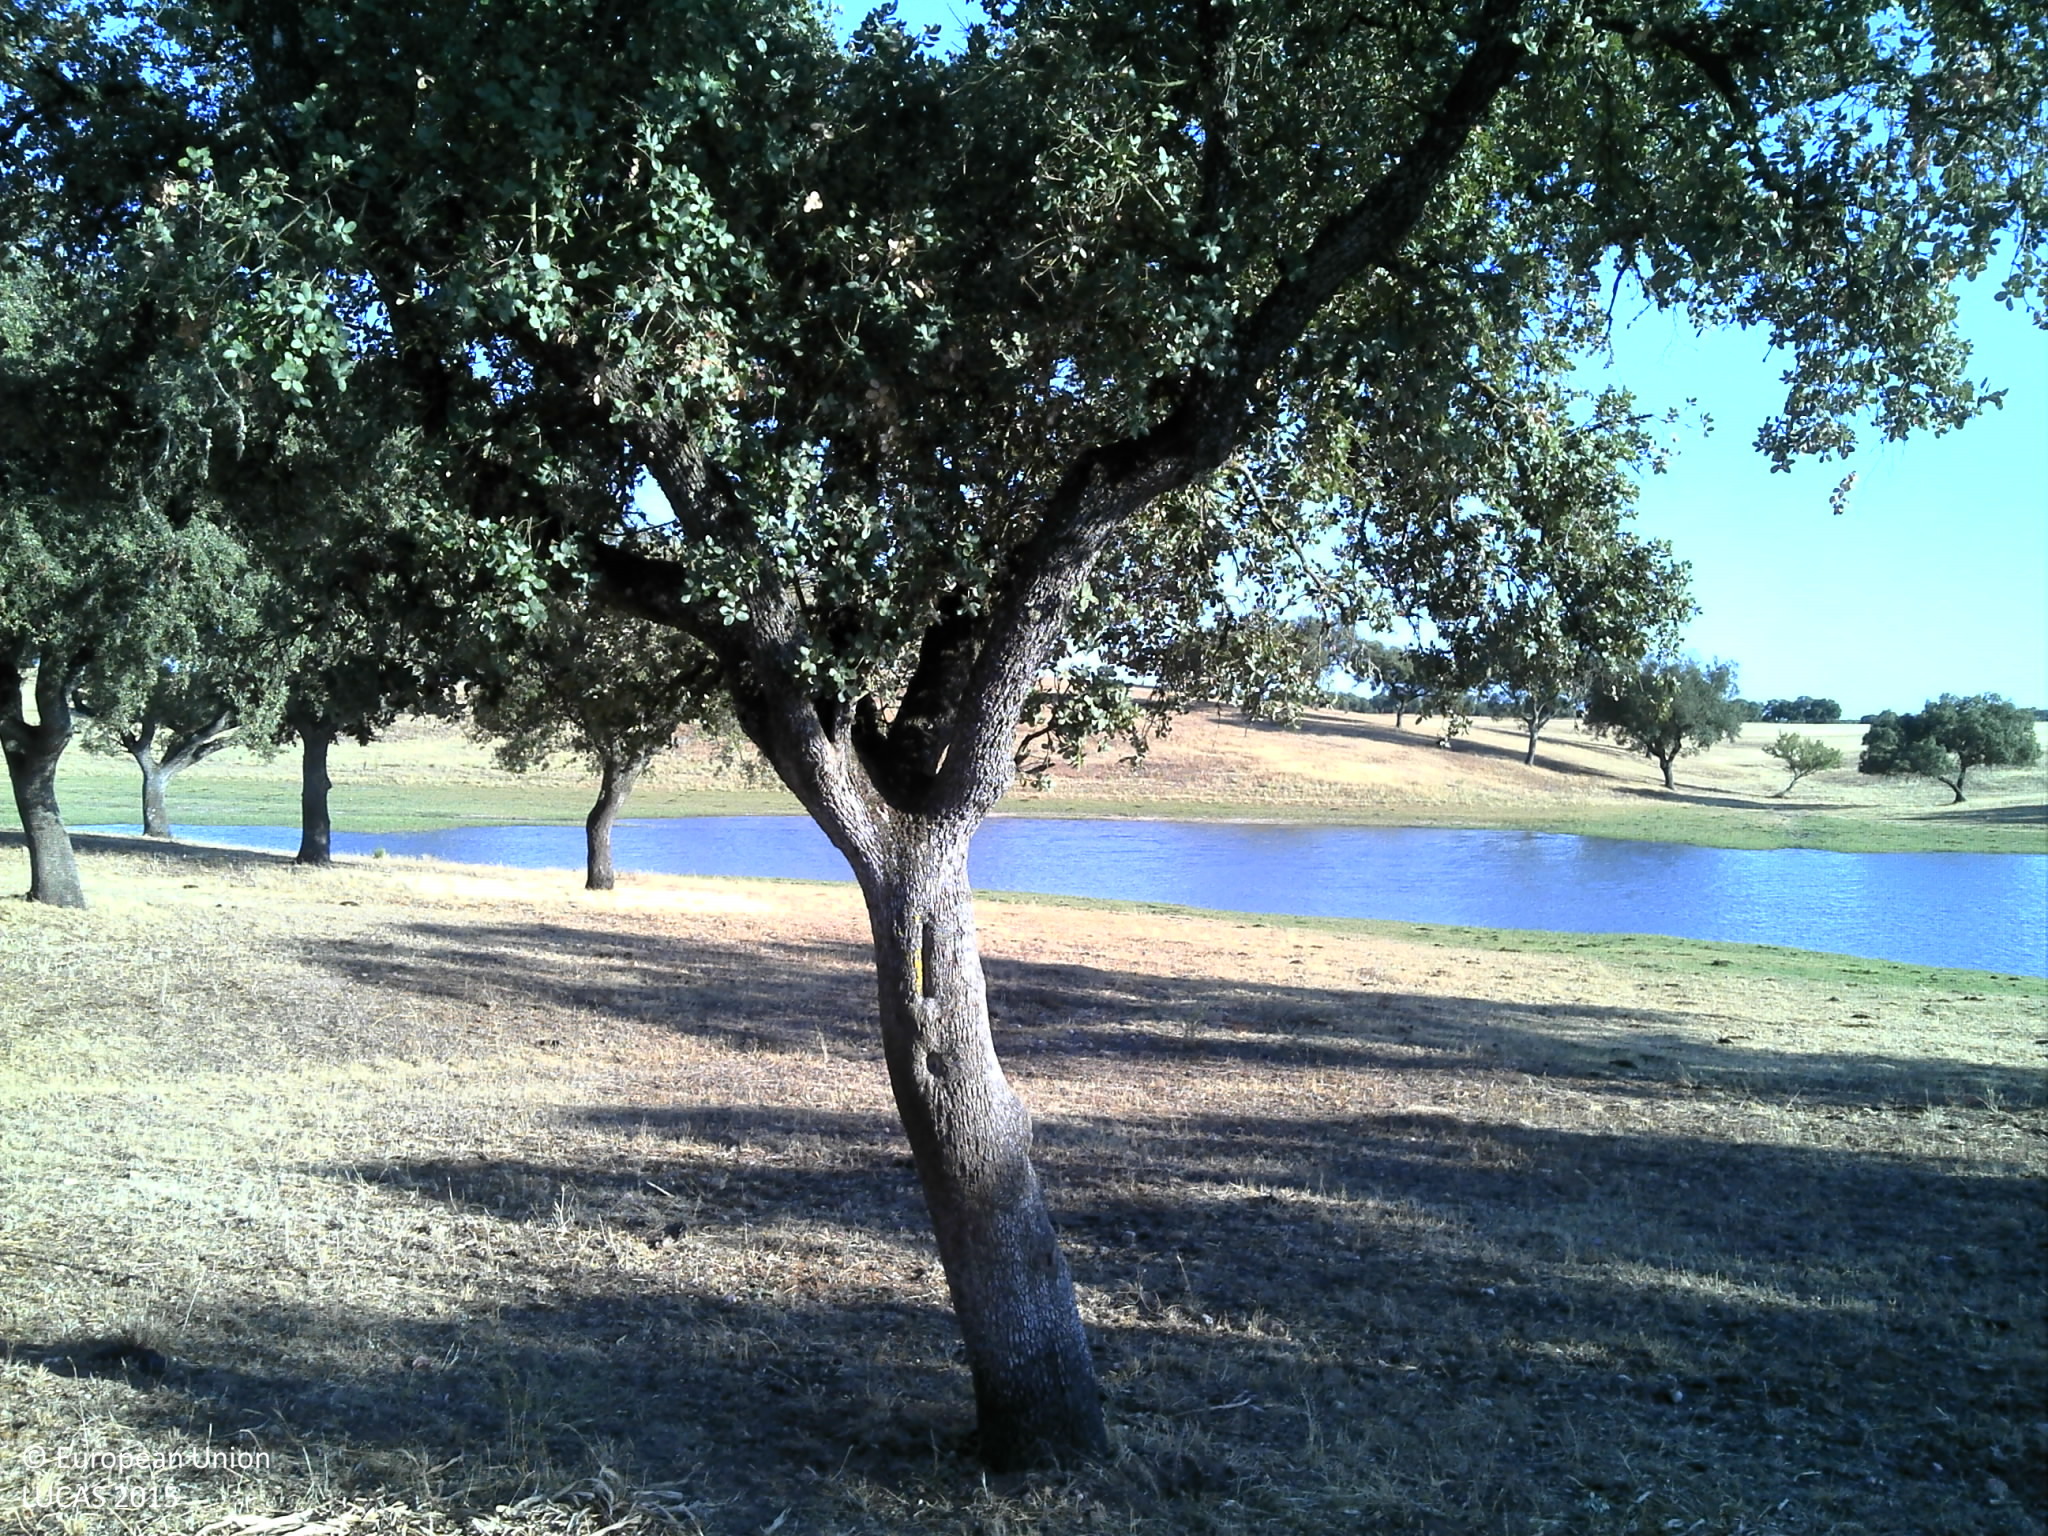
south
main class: Woodland
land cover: Broadleaved woodland
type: broadleaved evergreen forest
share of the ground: 10 - 25 %
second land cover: Grassland without tree/shrub cover
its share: < 10 %
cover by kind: unconsolidated bare surface 85 %, broadleaved forest trees 10 %, herbaceous plants 5 %
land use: Forestry
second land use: Agriculture (excluding fallow land and kitchen gardens)
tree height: > 5 m
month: June
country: PT
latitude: 38.2393
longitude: -8.0777
